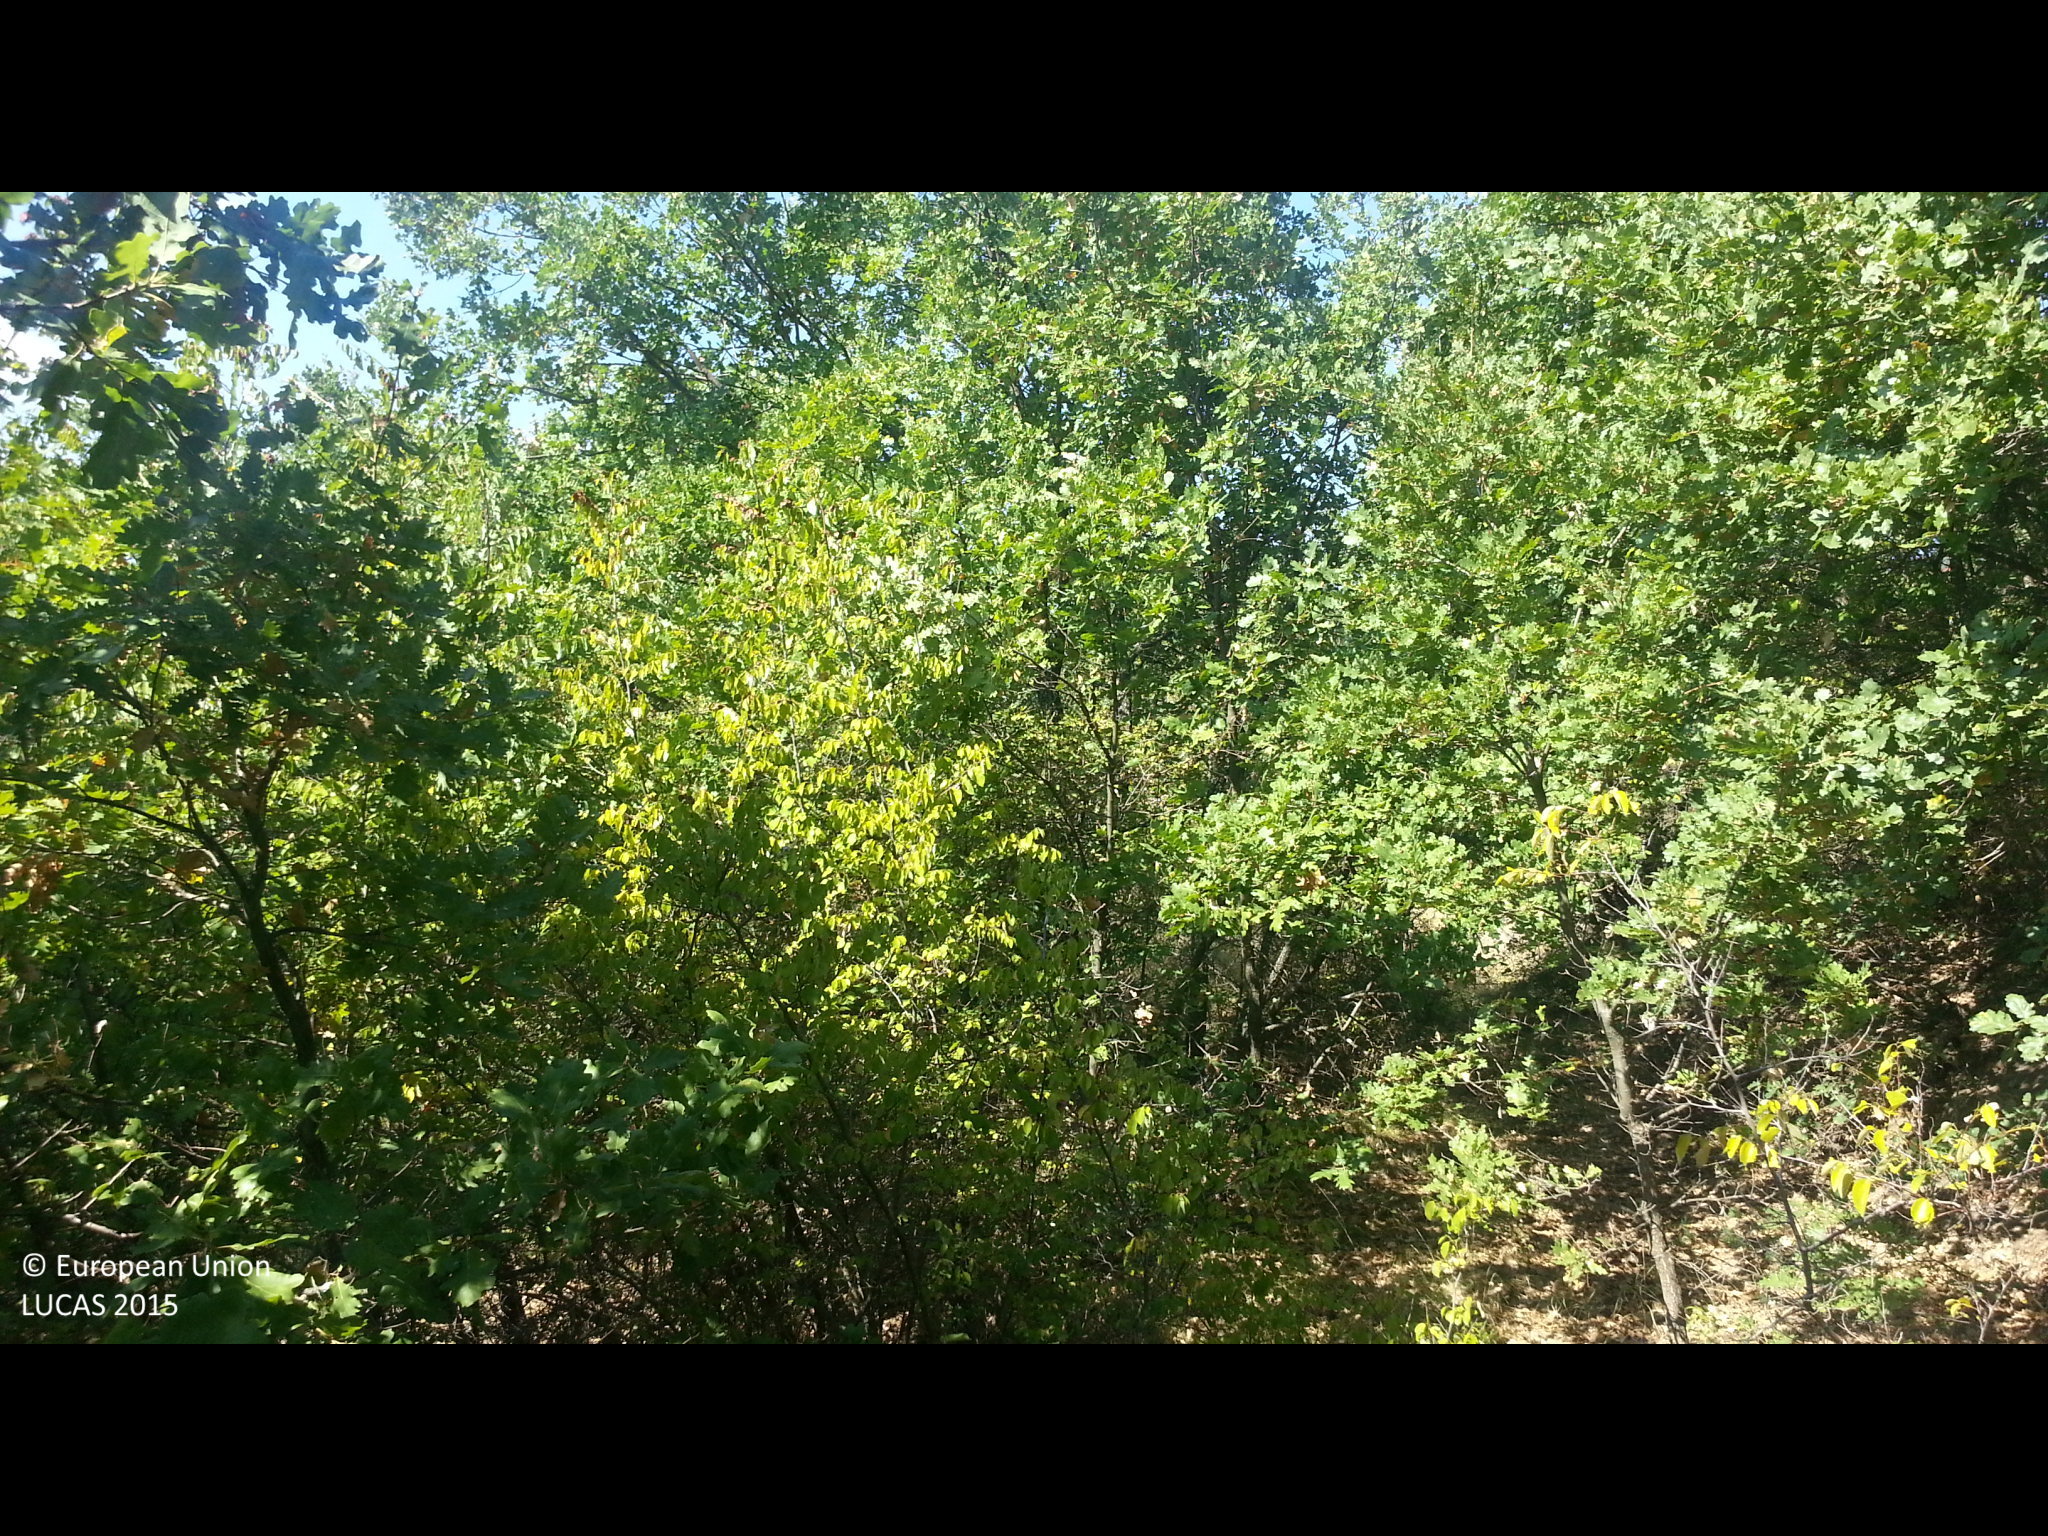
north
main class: Woodland
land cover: Broadleaved woodland
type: thermophilous deciduous forest
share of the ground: > 75 %
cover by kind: broadleaved forest trees 95 %, shrubs 5 %
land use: Forestry
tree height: > 5 m
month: September
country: BG
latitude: 42.1340
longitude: 23.0547
